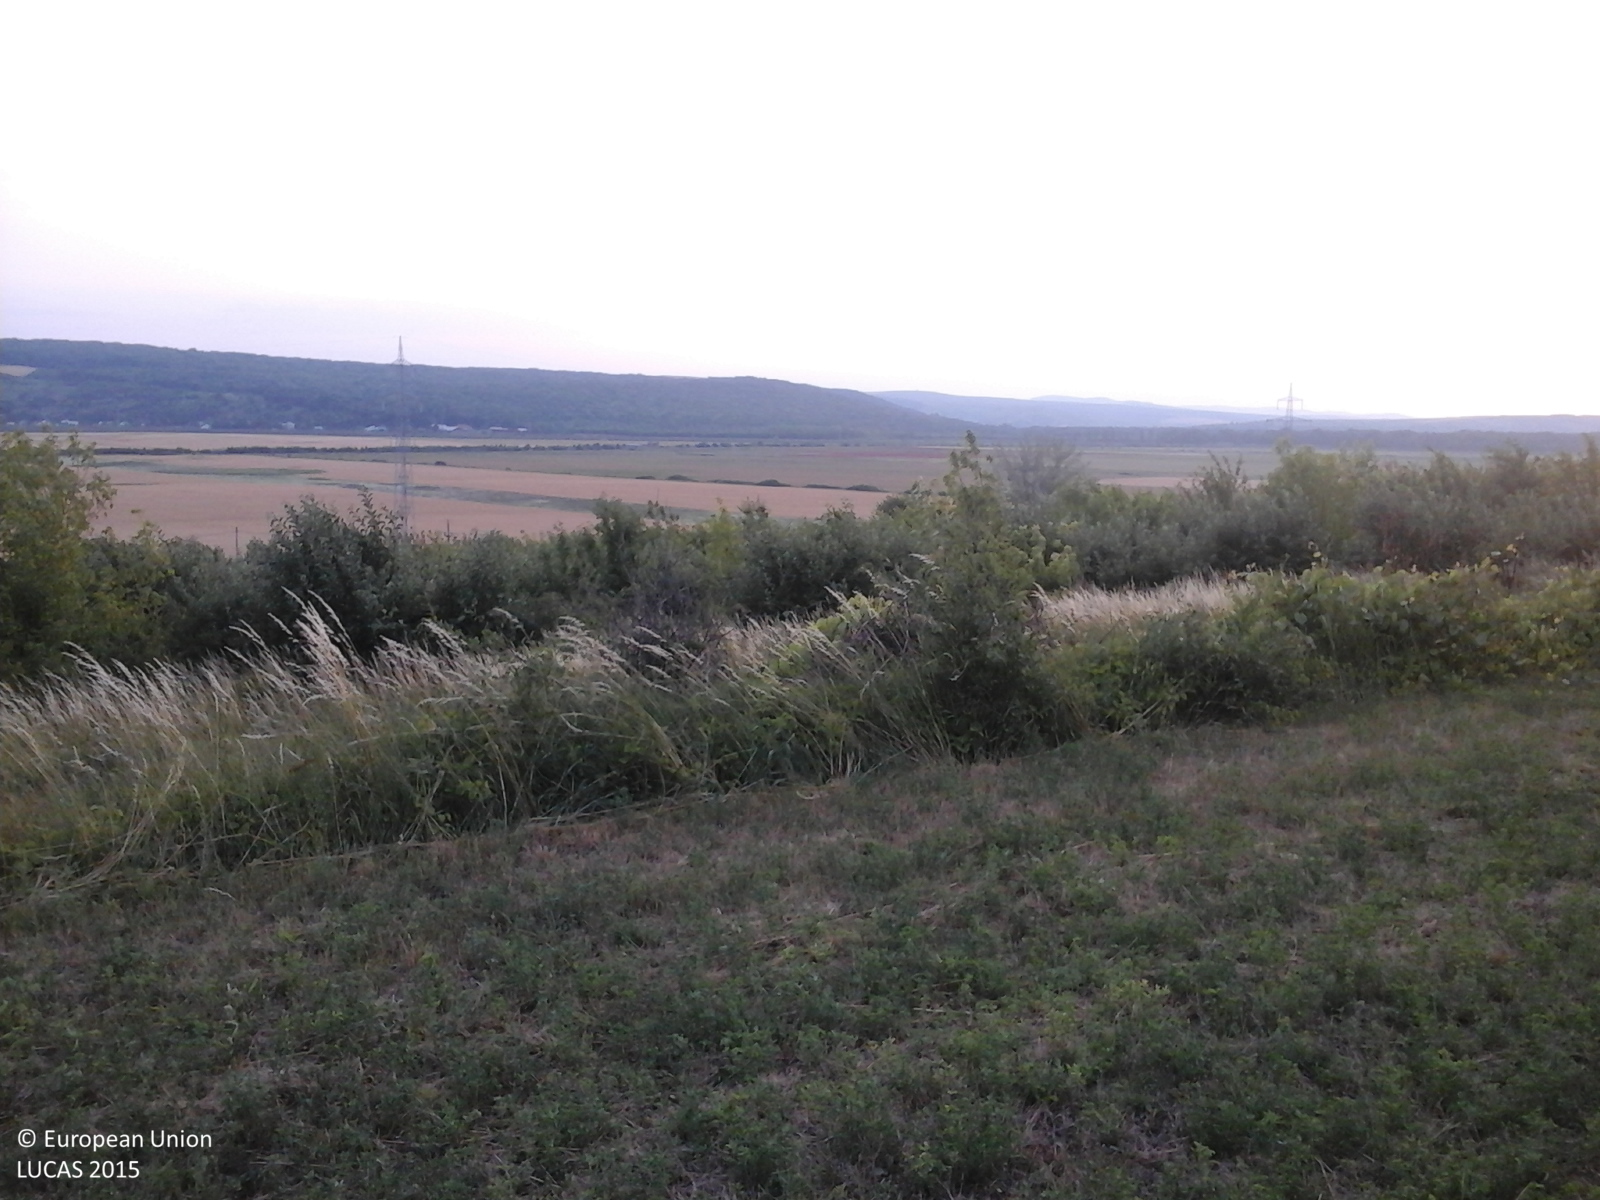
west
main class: Cropland
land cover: Lucerne
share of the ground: > 75 %
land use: Agriculture (excluding fallow land and kitchen gardens)
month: June
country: RO
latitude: 46.6657
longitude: 27.6972
